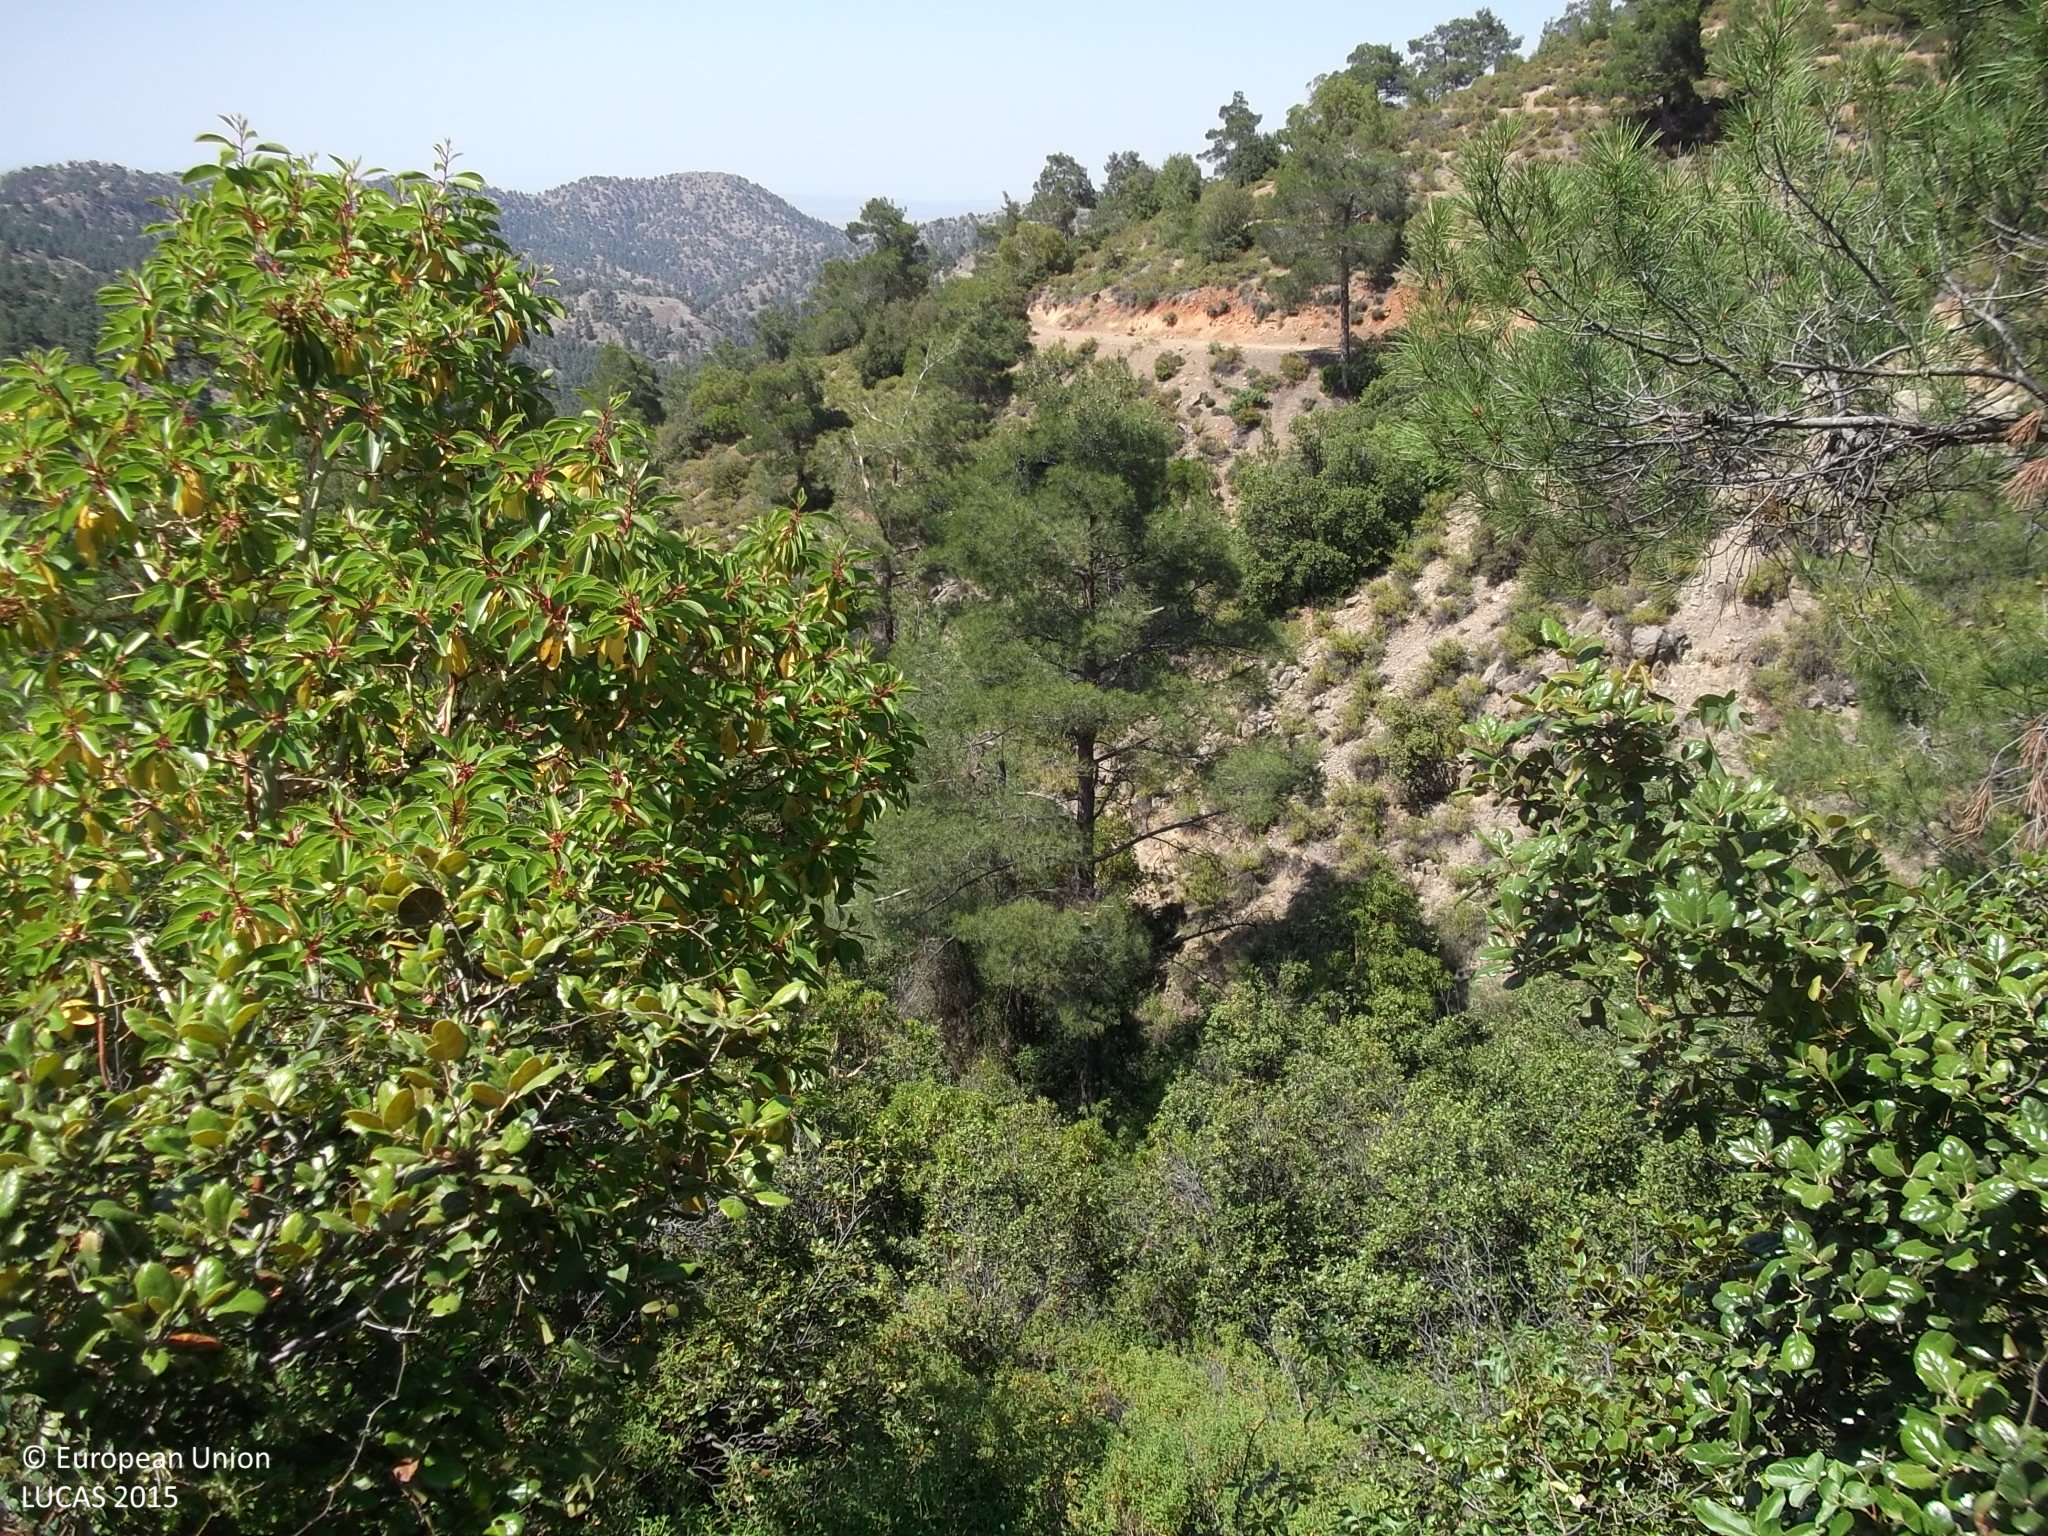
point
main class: Woodland
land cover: Pine dominated mixed woodland
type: coniferous forest of the mediterranean region
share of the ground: > 75 %
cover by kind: coniferous forest trees 60 %, broadleaved forest trees 25 %, shrubs 5 %, consolidated bare surface 5 %, unconsolidated bare surface 5 %
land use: Forestry
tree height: > 5 m
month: June
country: CY
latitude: 34.9825
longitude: 32.9226
